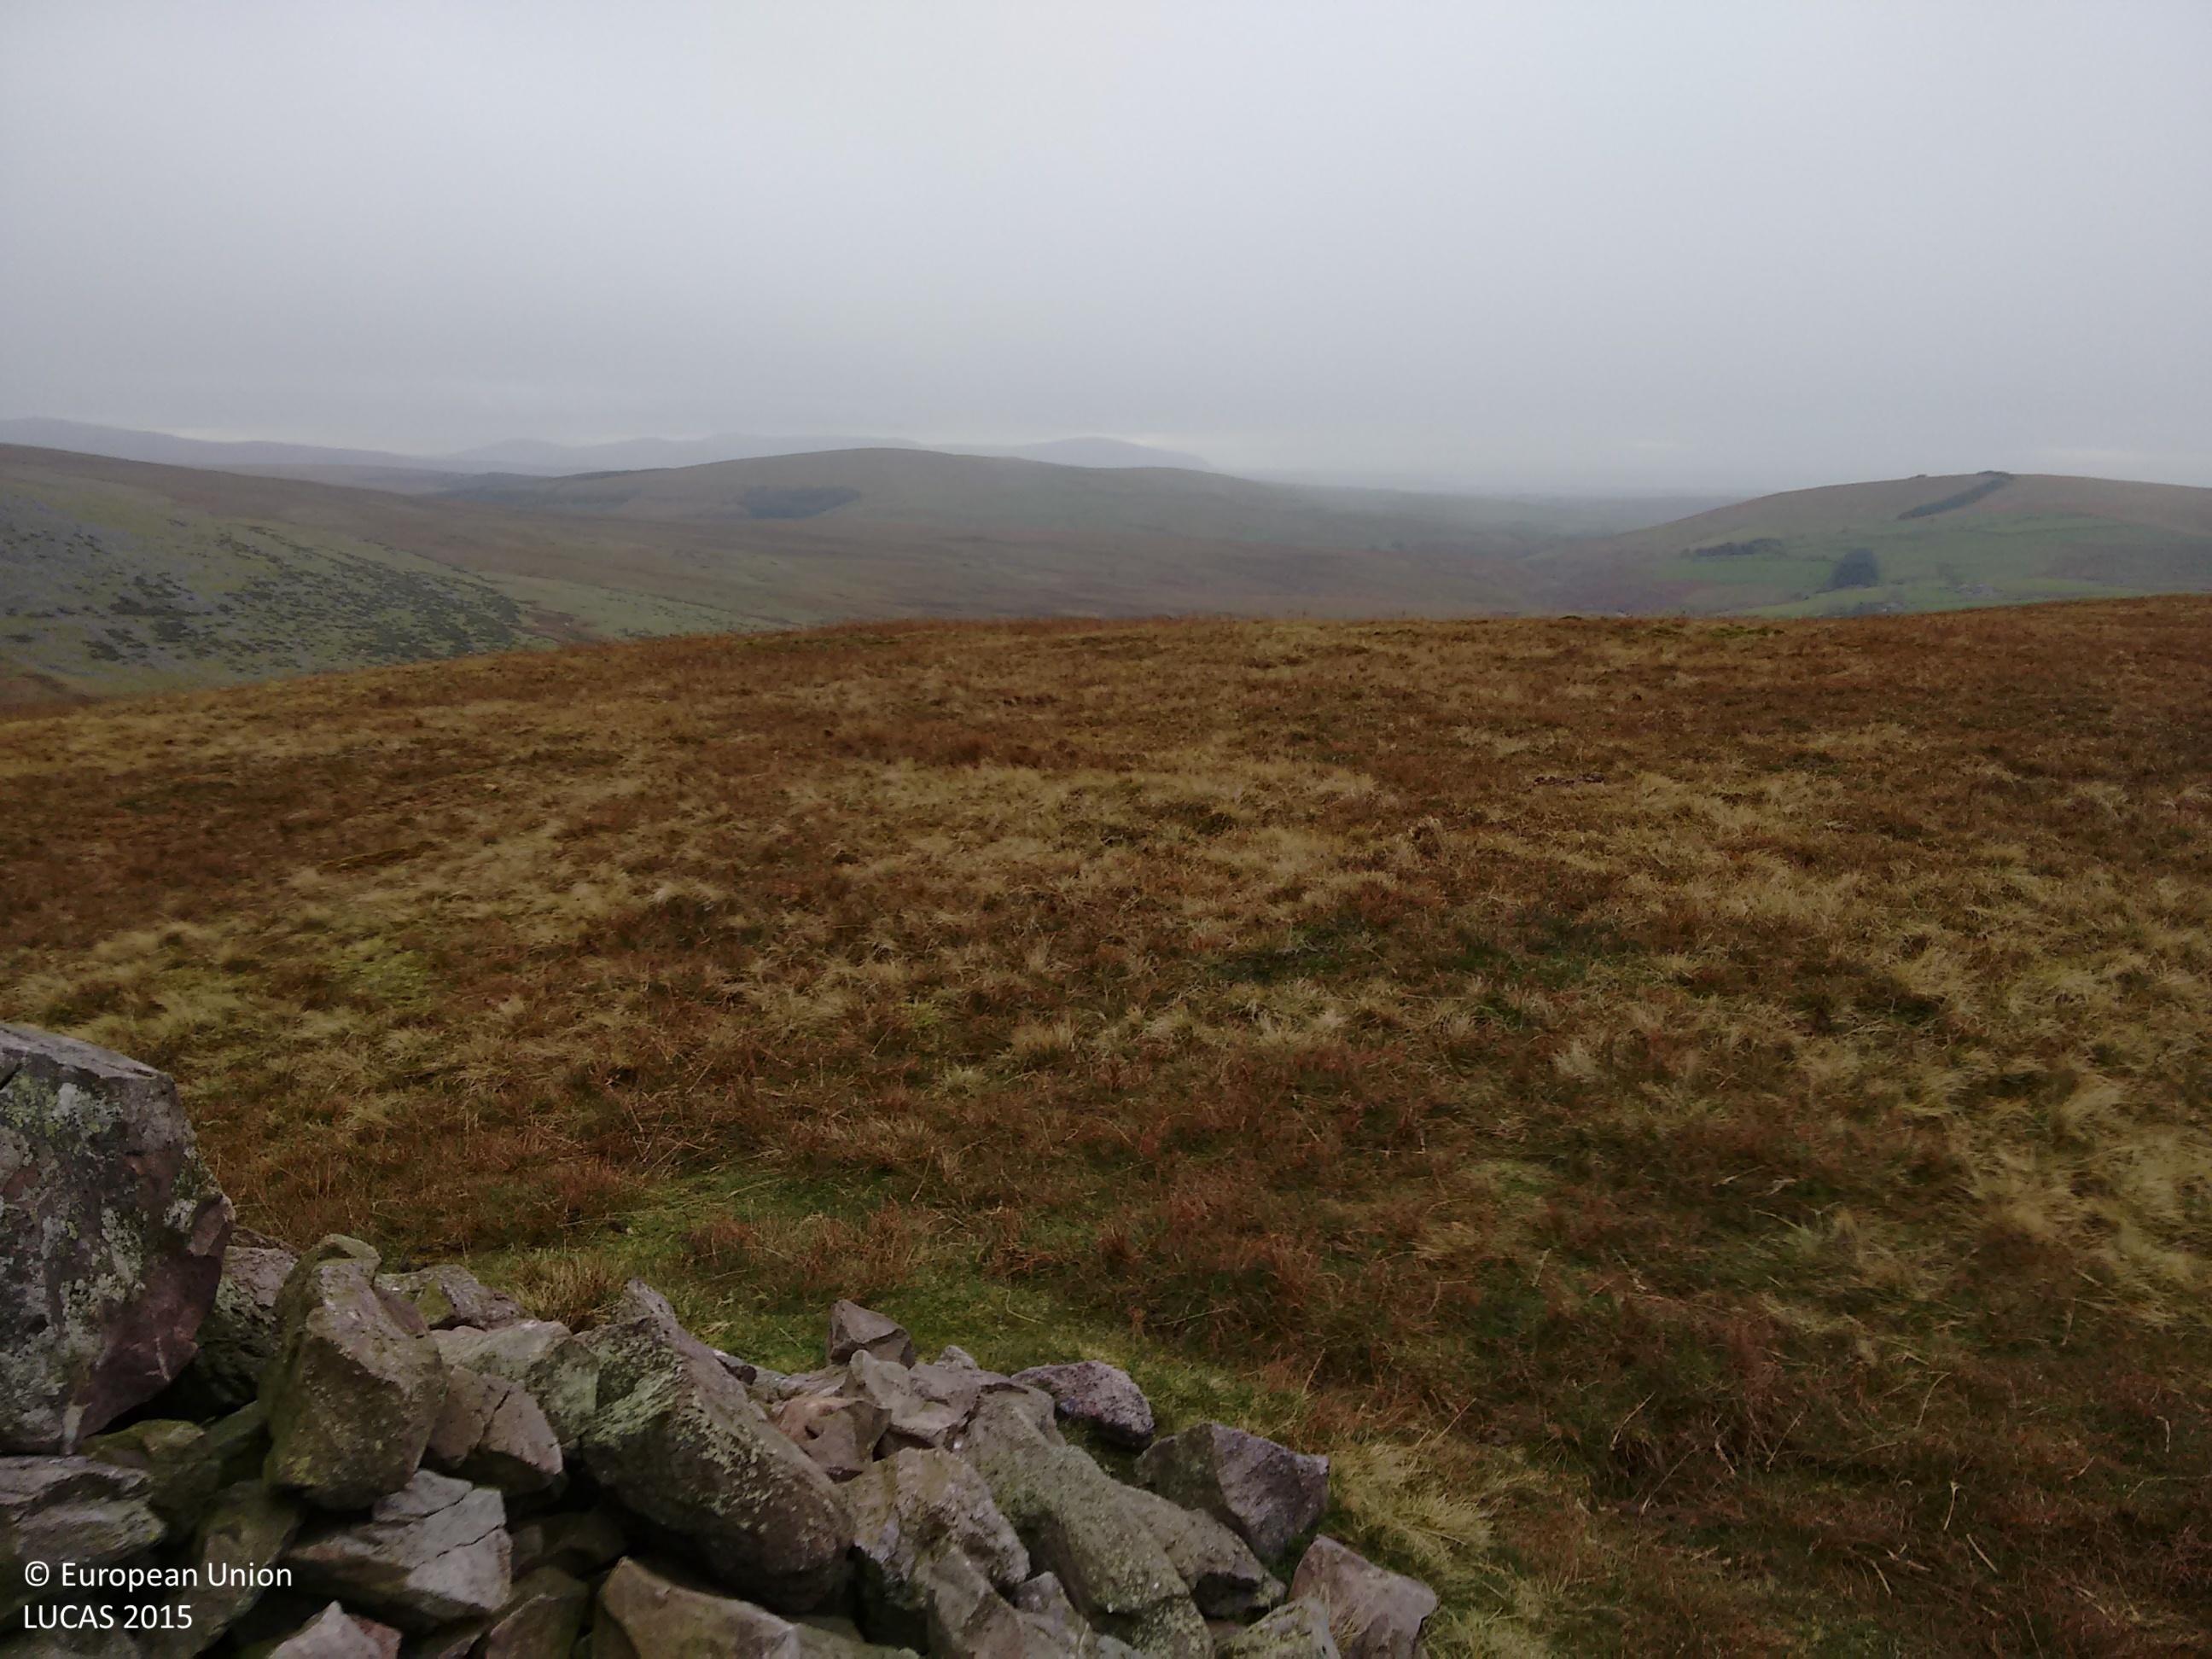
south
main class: Grassland
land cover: Grassland without tree/shrub cover
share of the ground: > 75 %
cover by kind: herbaceous plants 100 %
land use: Agriculture (excluding fallow land and kitchen gardens)
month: November
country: GB
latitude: 54.4914
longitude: -3.4346
